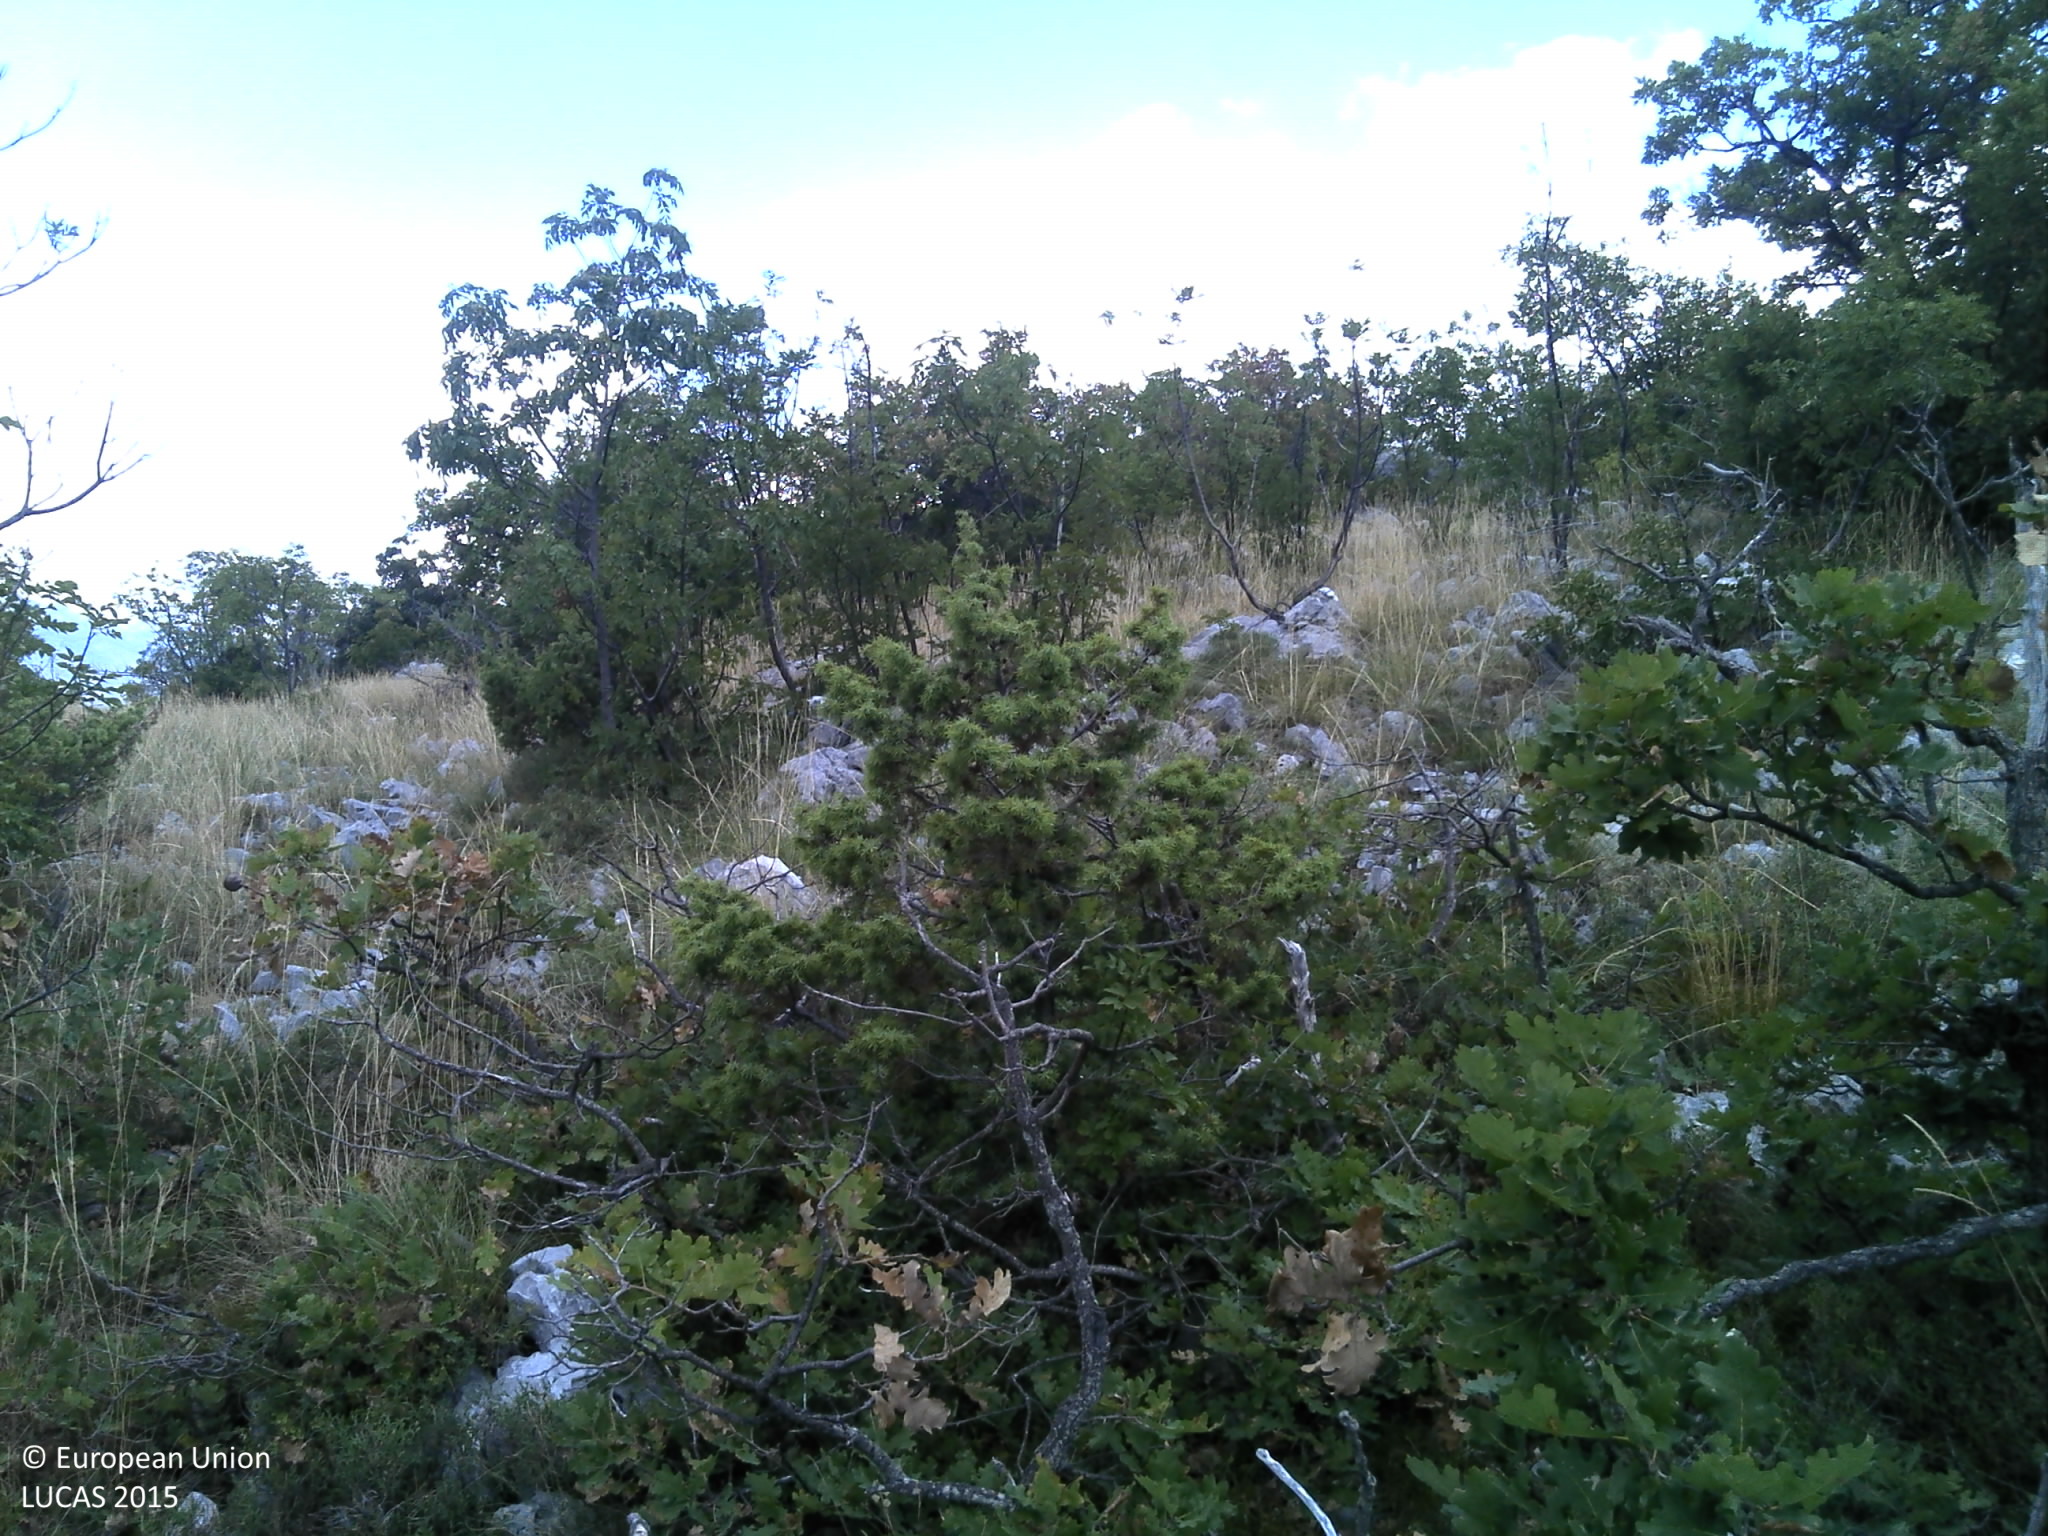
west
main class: Shrubland
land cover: Shrubland with sparse tree cover
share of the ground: > 75 %
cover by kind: shrubs 65 %, herbaceous plants 15 %, unconsolidated bare surface 10 %, broadleaved forest trees 5 %, consolidated bare surface 5 %
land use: Semi-natural and natural areas not in use
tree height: < 5 m
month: August
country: HR
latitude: 43.3016
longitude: 17.2274
